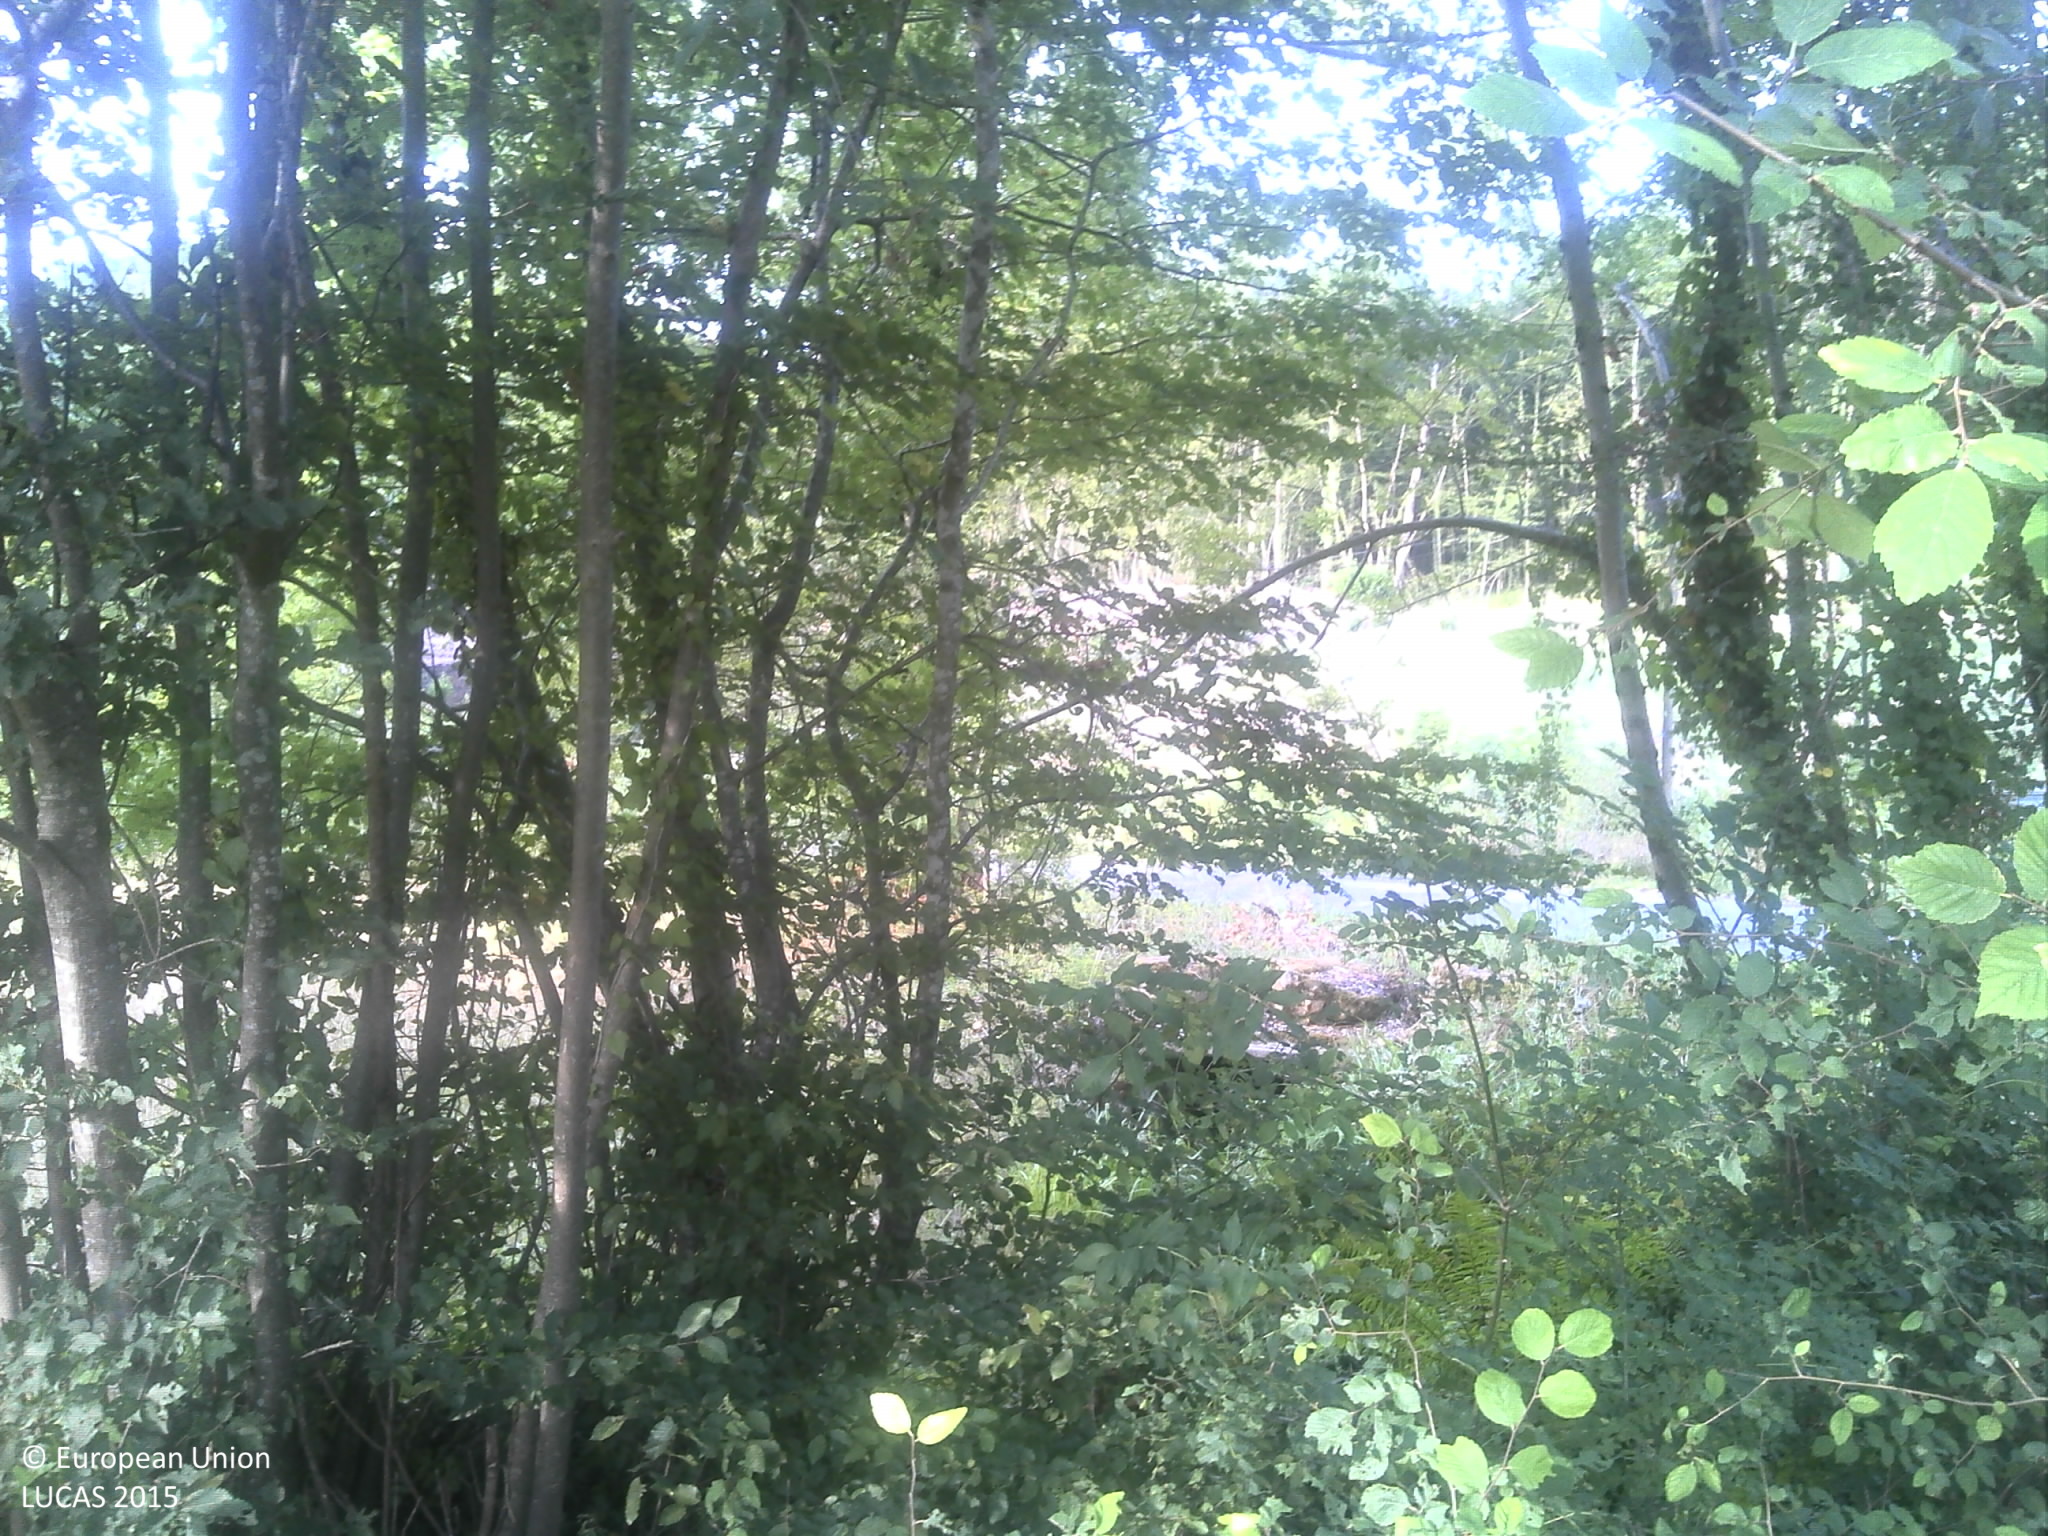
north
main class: Grassland
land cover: Grassland without tree/shrub cover
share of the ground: > 75 %
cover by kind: herbaceous plants 100 %
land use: Agriculture (excluding fallow land and kitchen gardens)
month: August
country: FR
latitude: 45.2197
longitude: 1.5521
